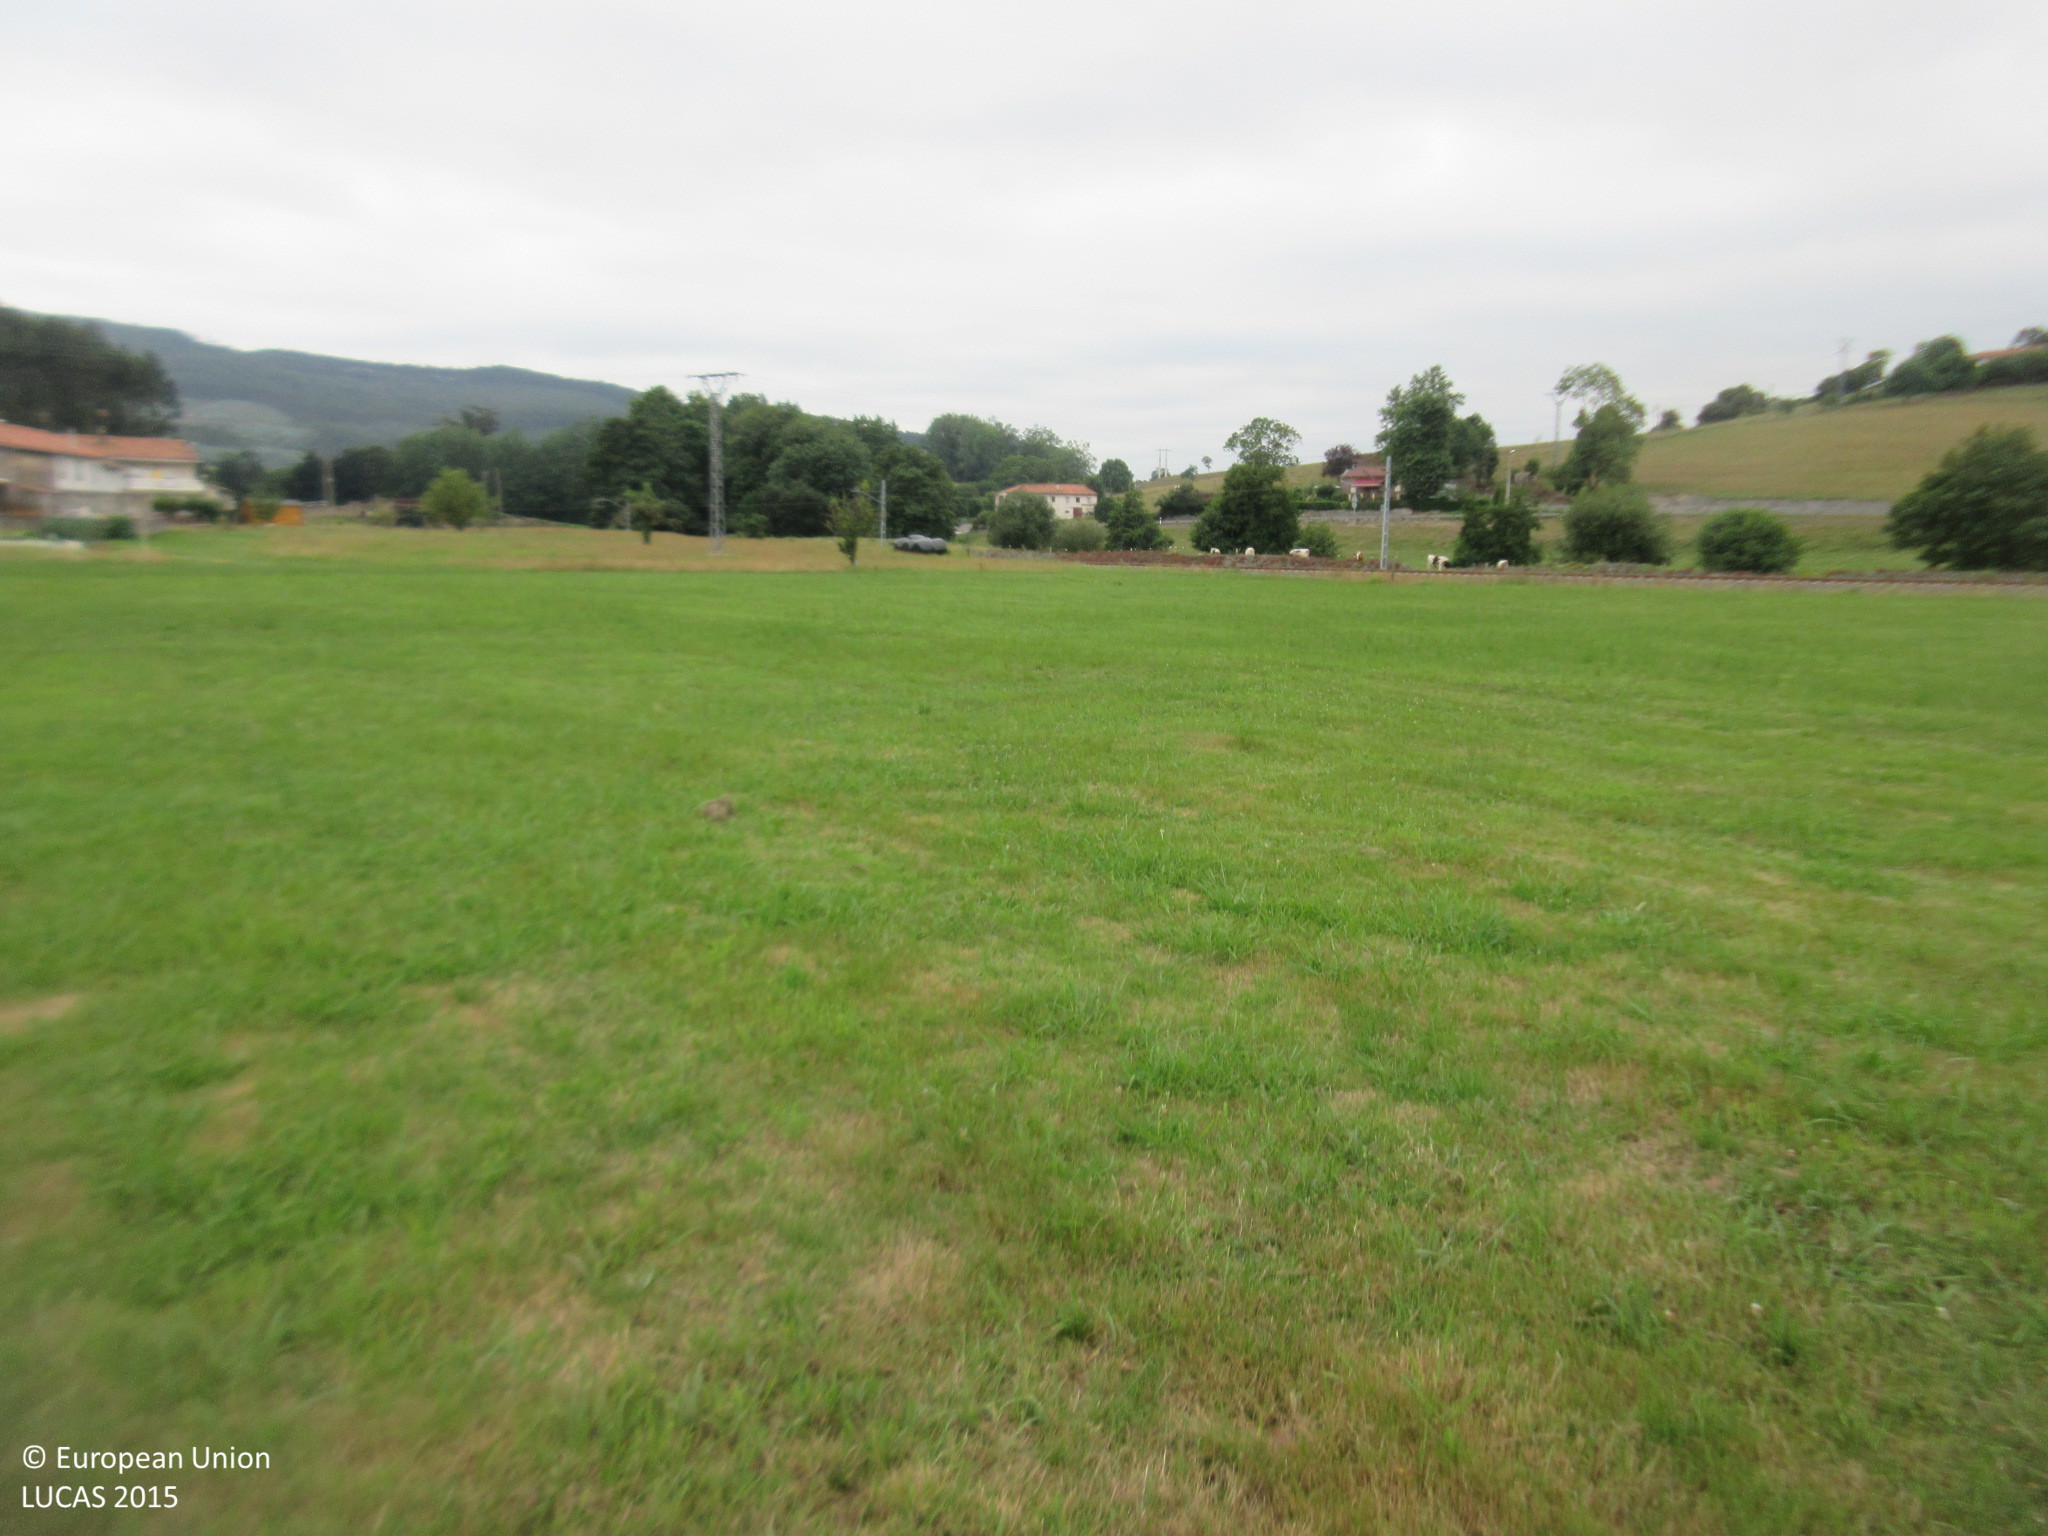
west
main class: Grassland
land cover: Grassland without tree/shrub cover
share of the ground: > 75 %
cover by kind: herbaceous plants 100 %
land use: Agriculture (excluding fallow land and kitchen gardens)
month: July
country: ES
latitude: 43.3509
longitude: -3.9294
